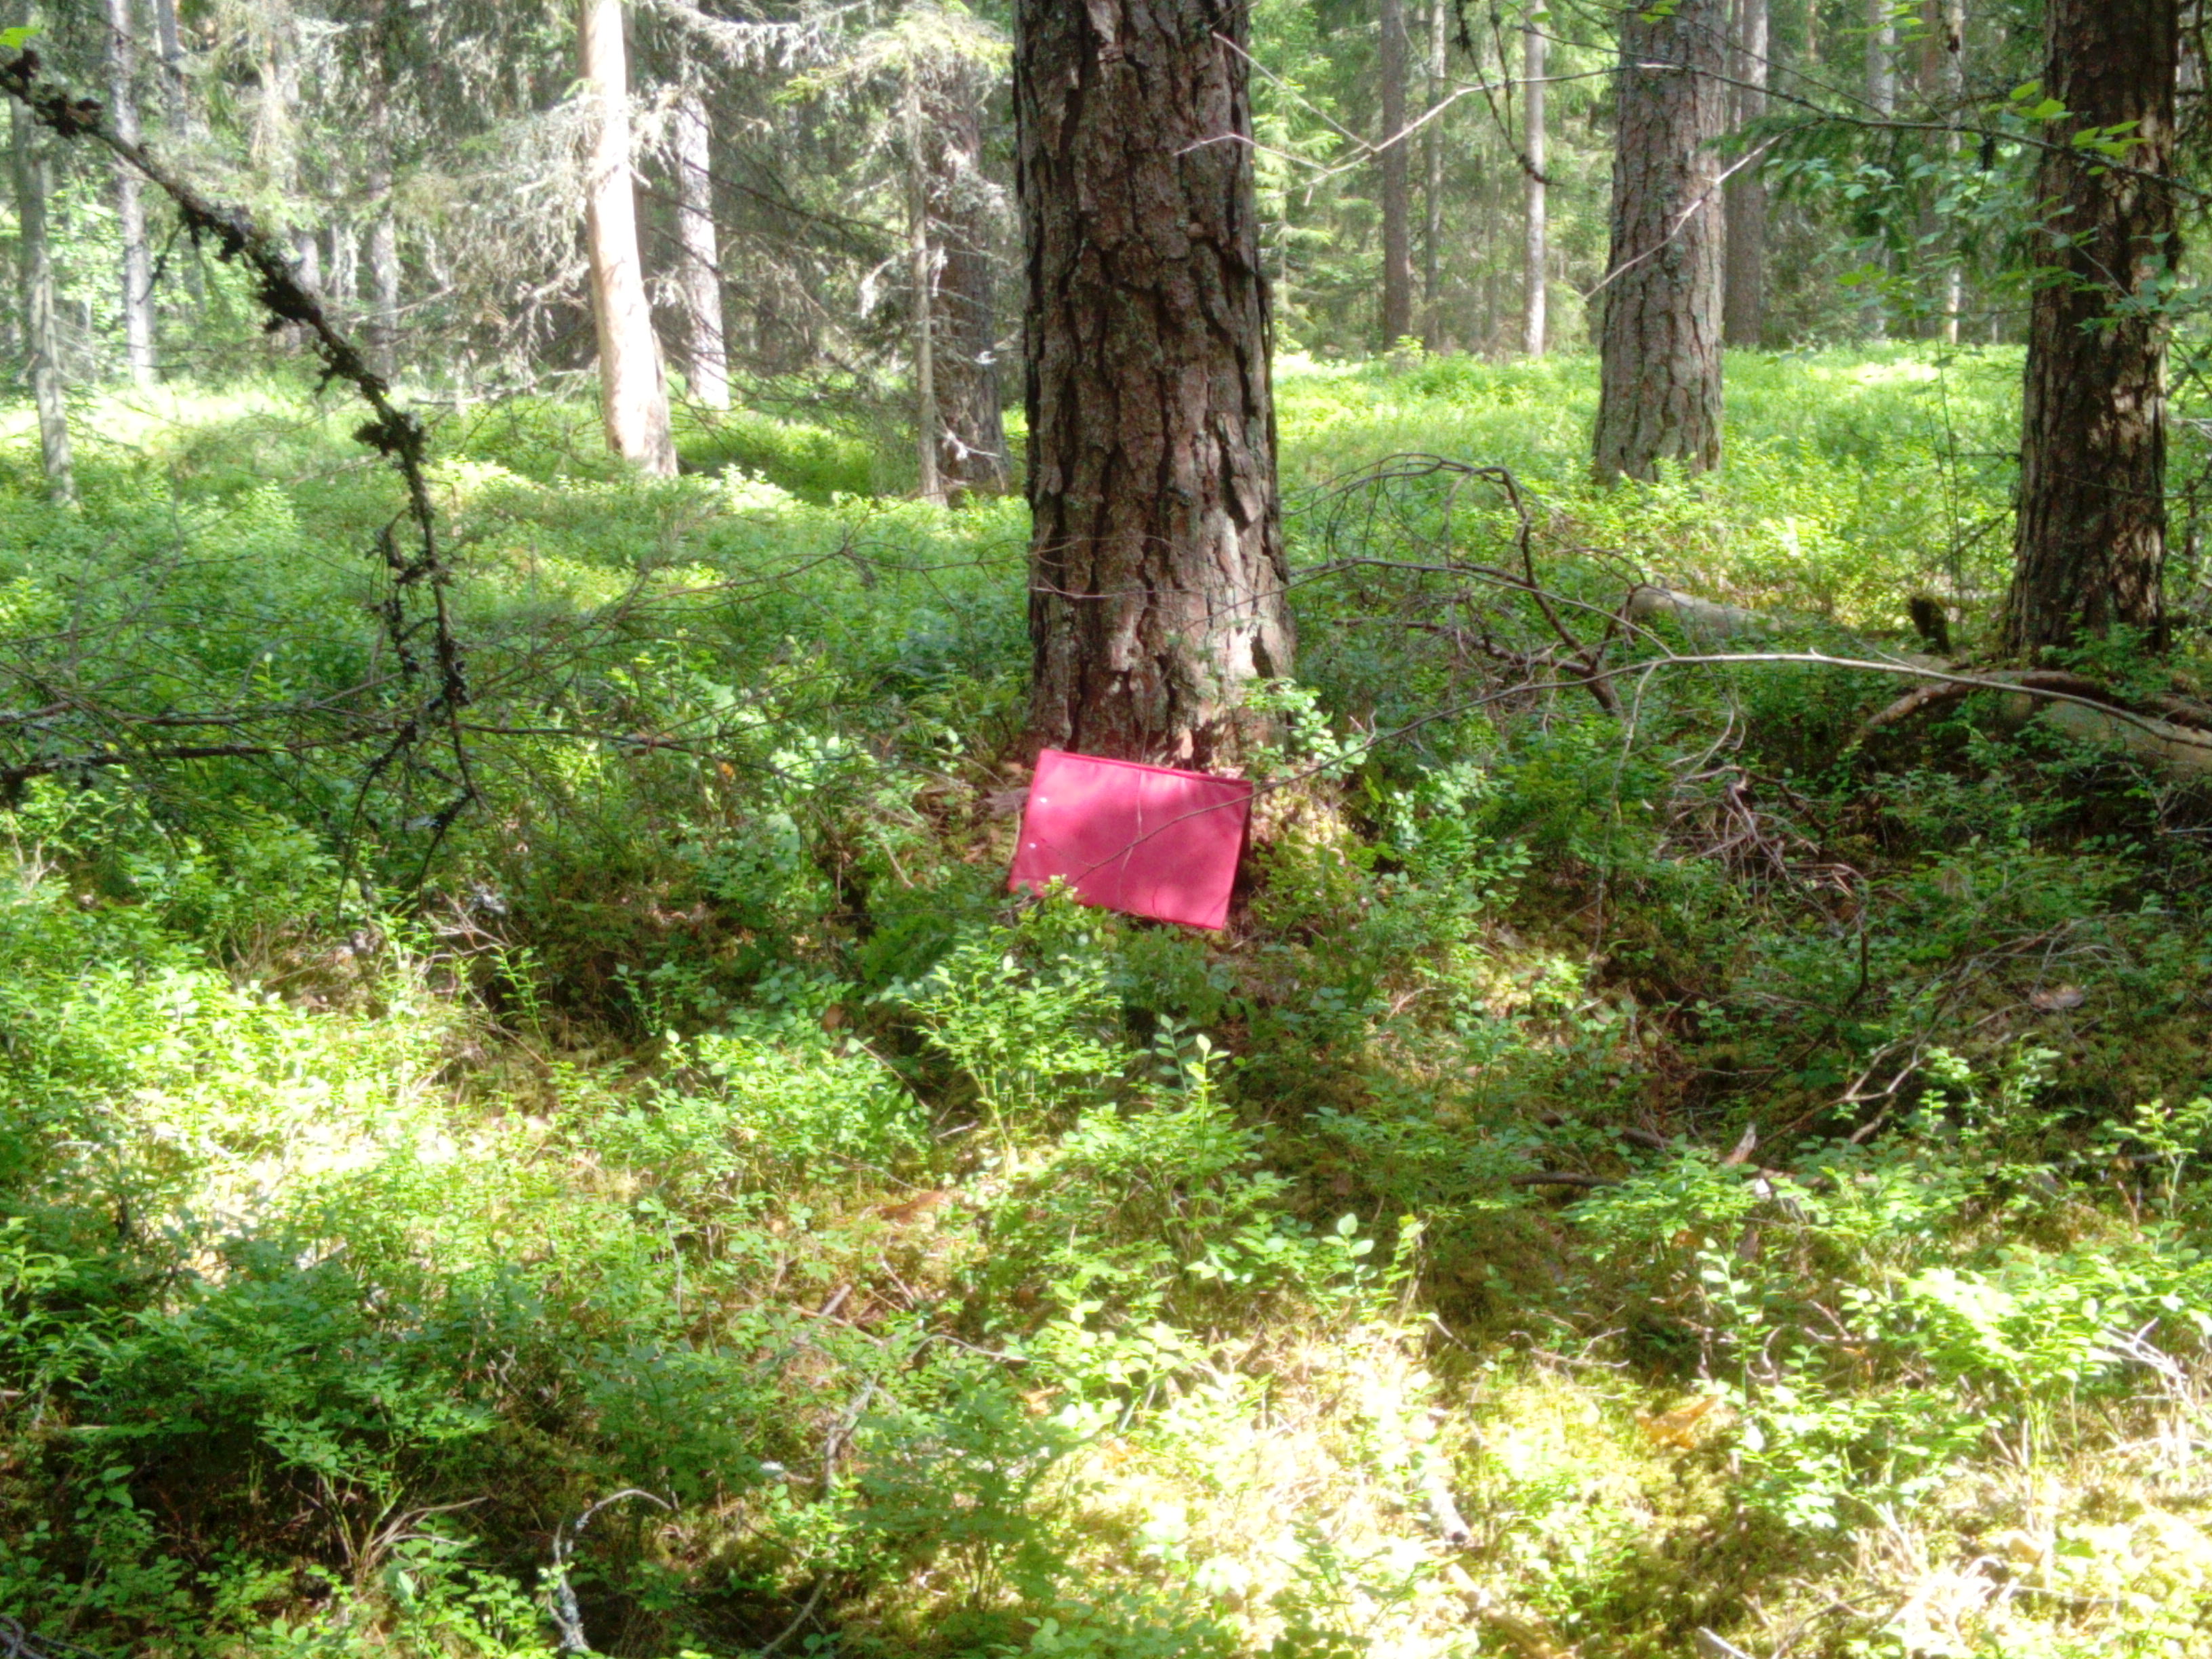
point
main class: Woodland
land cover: Other coniferous woodland
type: hemiboreal forest and nemoral coniferous forest and mixed broadleaved-coniferous forest
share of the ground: > 75 %
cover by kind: coniferous forest trees 80 %, herbaceous plants 10 %, broadleaved forest trees 5 %, lichens and mosses 5 %
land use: Forestry
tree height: > 5 m
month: July
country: LV
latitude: 56.9621
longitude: 22.2710
